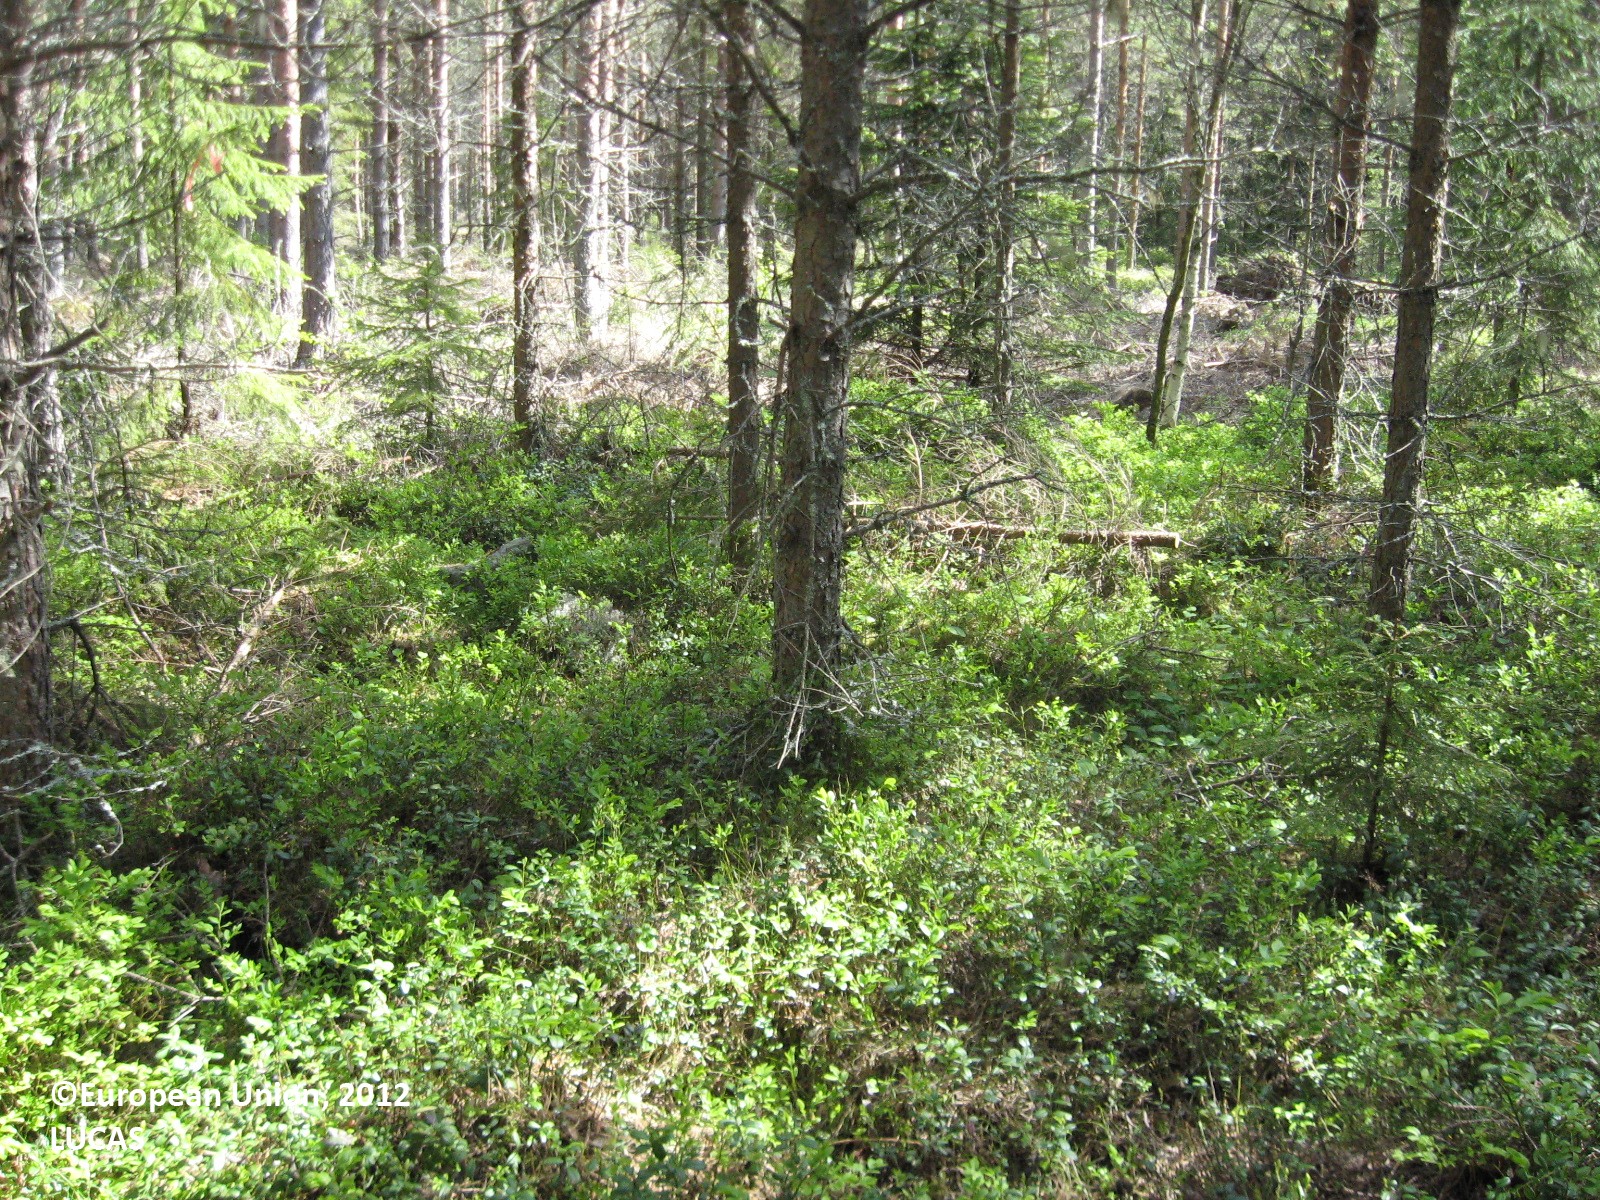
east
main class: Woodland
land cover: Pine dominated coniferous woodland
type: boreal forest
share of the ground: > 75 %
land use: Forestry
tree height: > 5 m
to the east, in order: Pine dominated coniferous woodland; Tracks; Spruce dominated coniferous woodland; Broadleaved woodland; Spruce dominated coniferous woodland
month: June
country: FI
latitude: 63.2161
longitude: 21.4346
